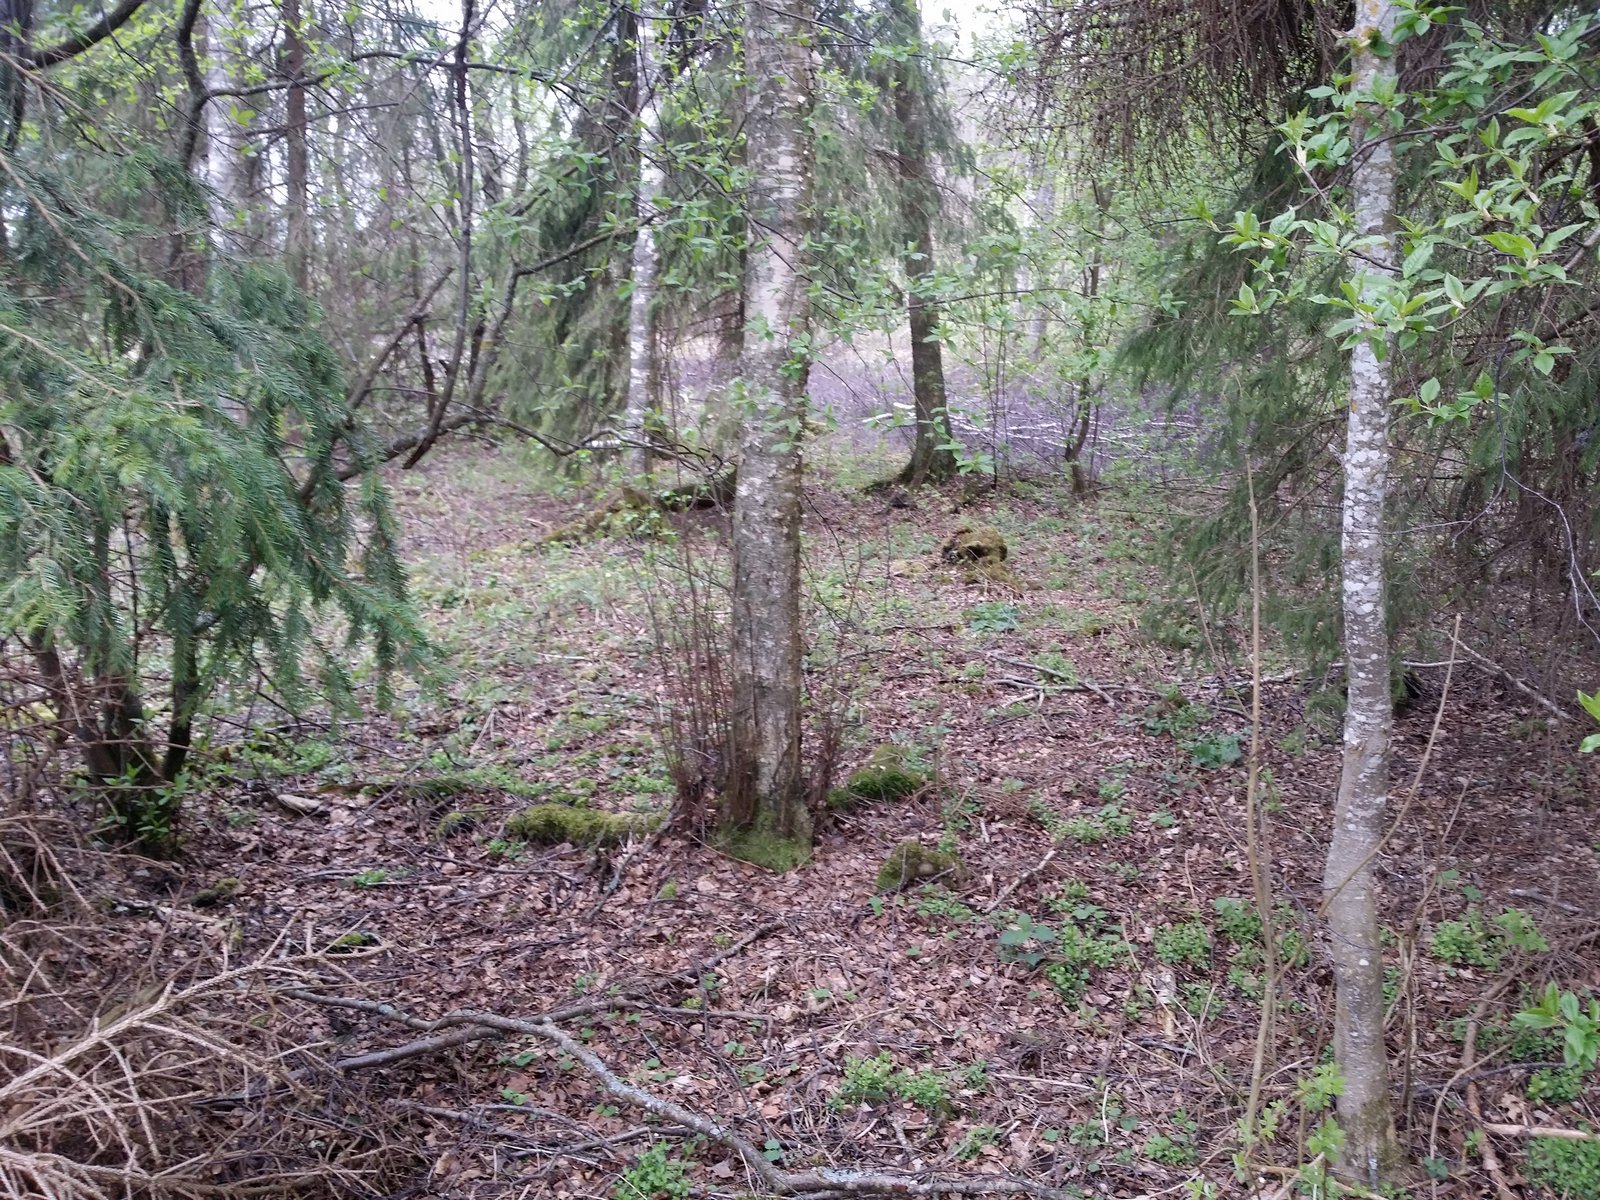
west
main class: Woodland
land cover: Spruce dominated mixed woodland
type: hemiboreal forest and nemoral coniferous forest and mixed broadleaved-coniferous forest
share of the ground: > 75 %
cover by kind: coniferous forest trees 40 %, broadleaved forest trees 40 %, lichens and mosses 20 %
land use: Forestry
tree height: > 5 m
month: May
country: LV
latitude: 57.5355
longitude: 26.0822
